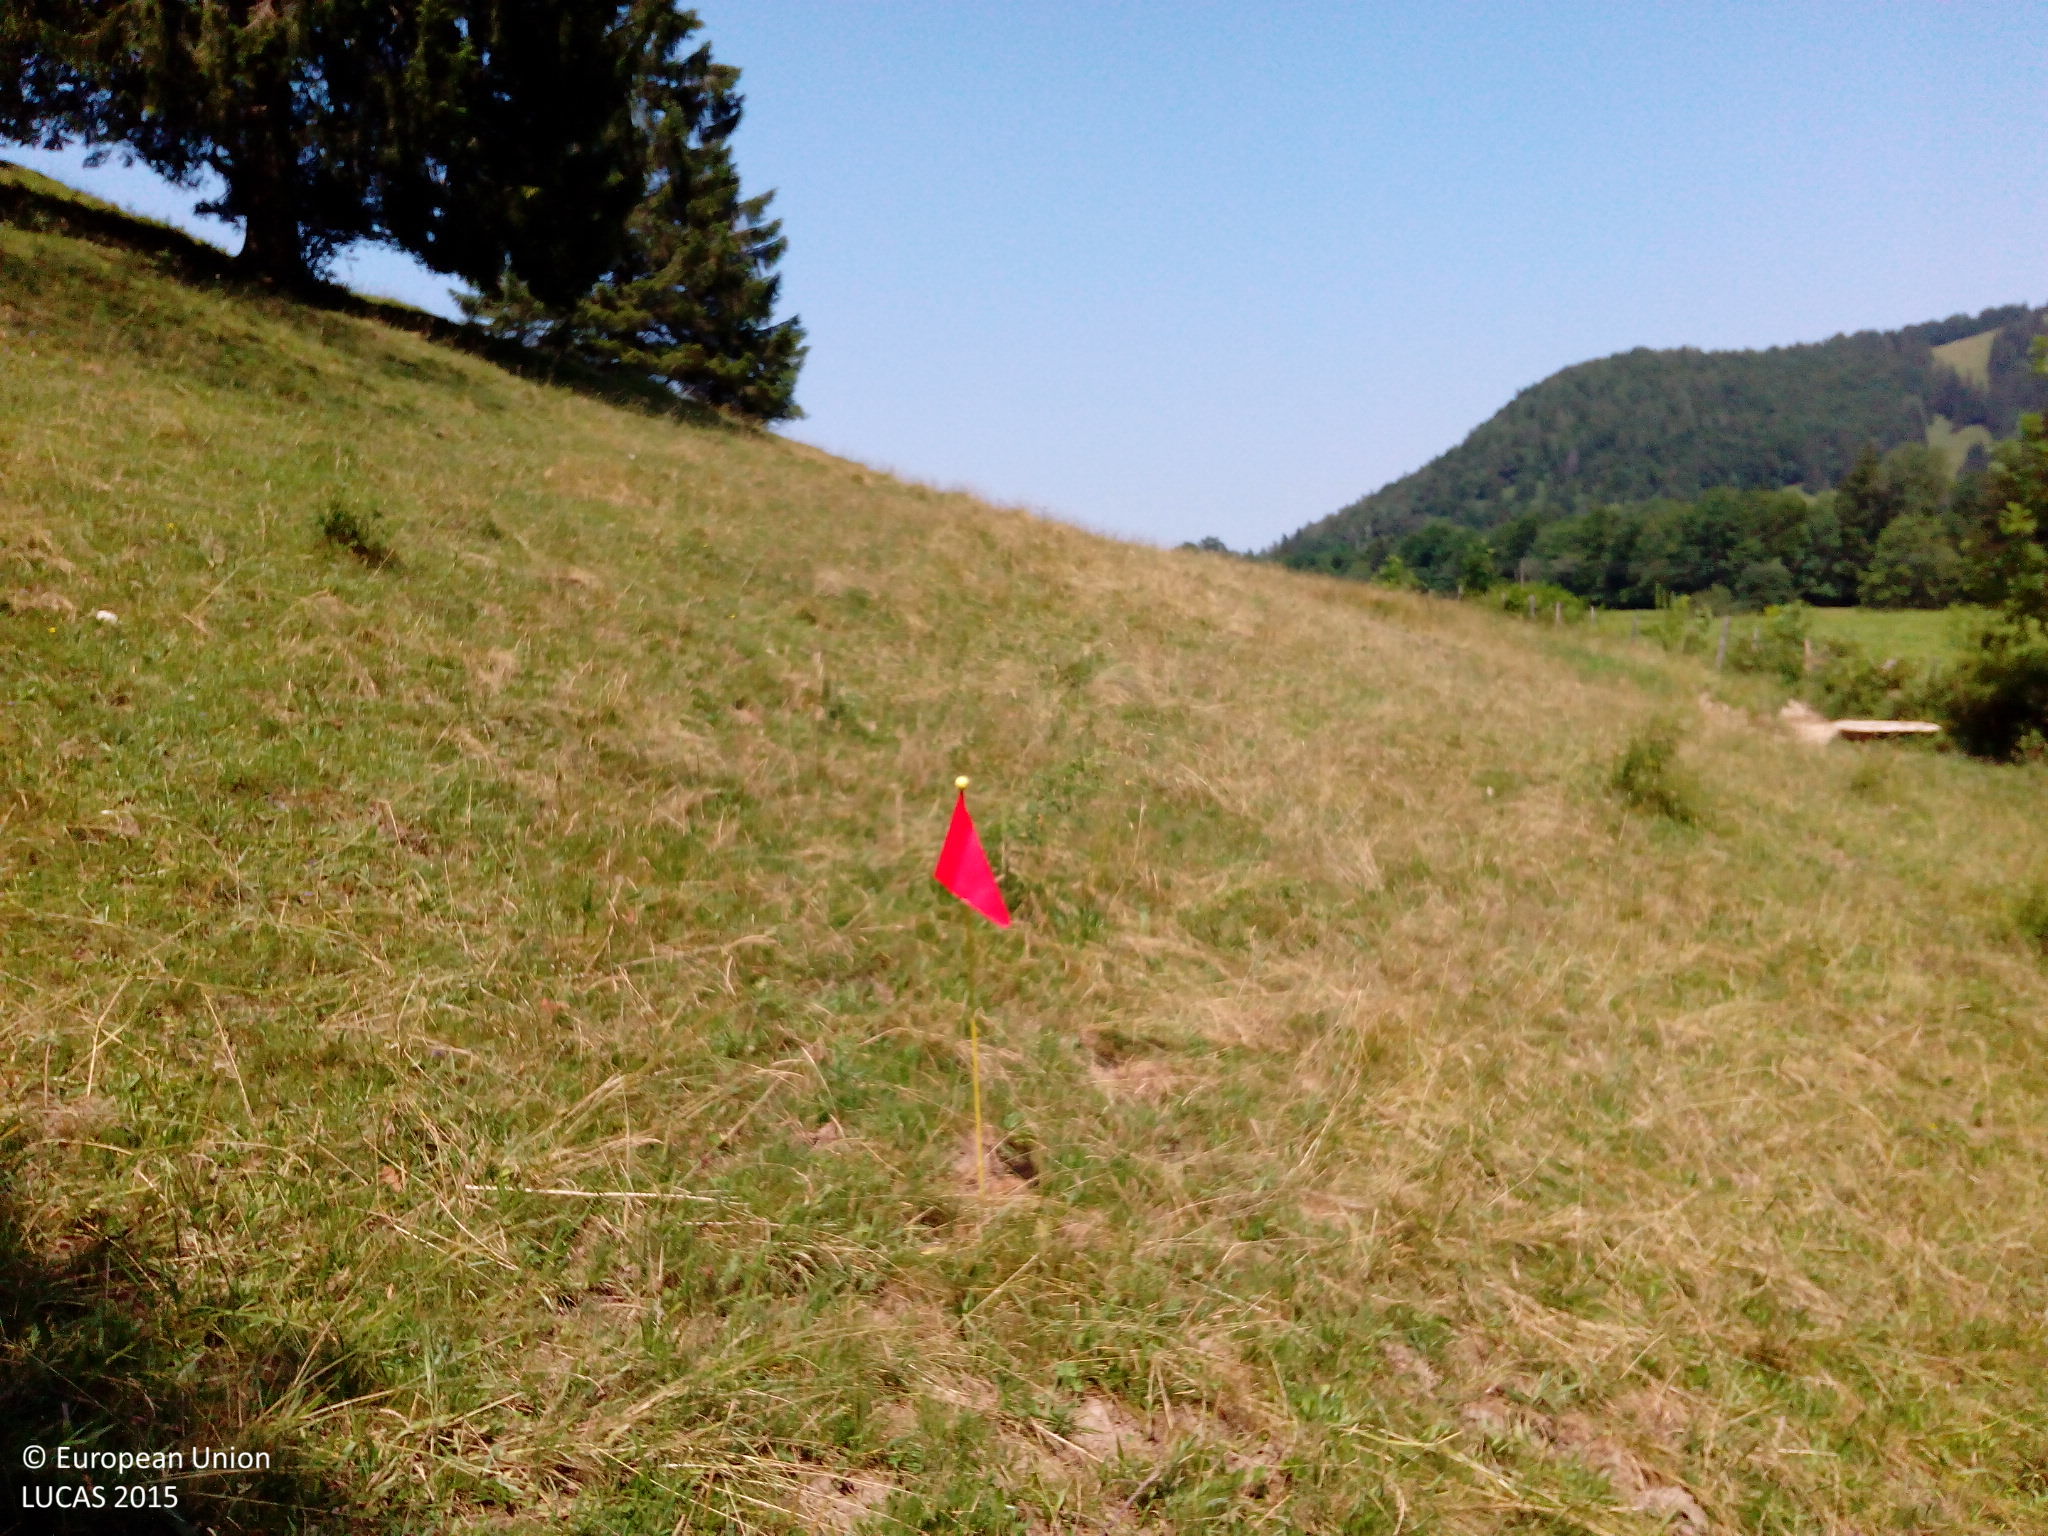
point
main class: Grassland
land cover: Grassland without tree/shrub cover
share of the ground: > 75 %
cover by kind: herbaceous plants 100 %
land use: Agriculture (excluding fallow land and kitchen gardens)
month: July
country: DE
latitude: 47.7842
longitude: 12.3611
